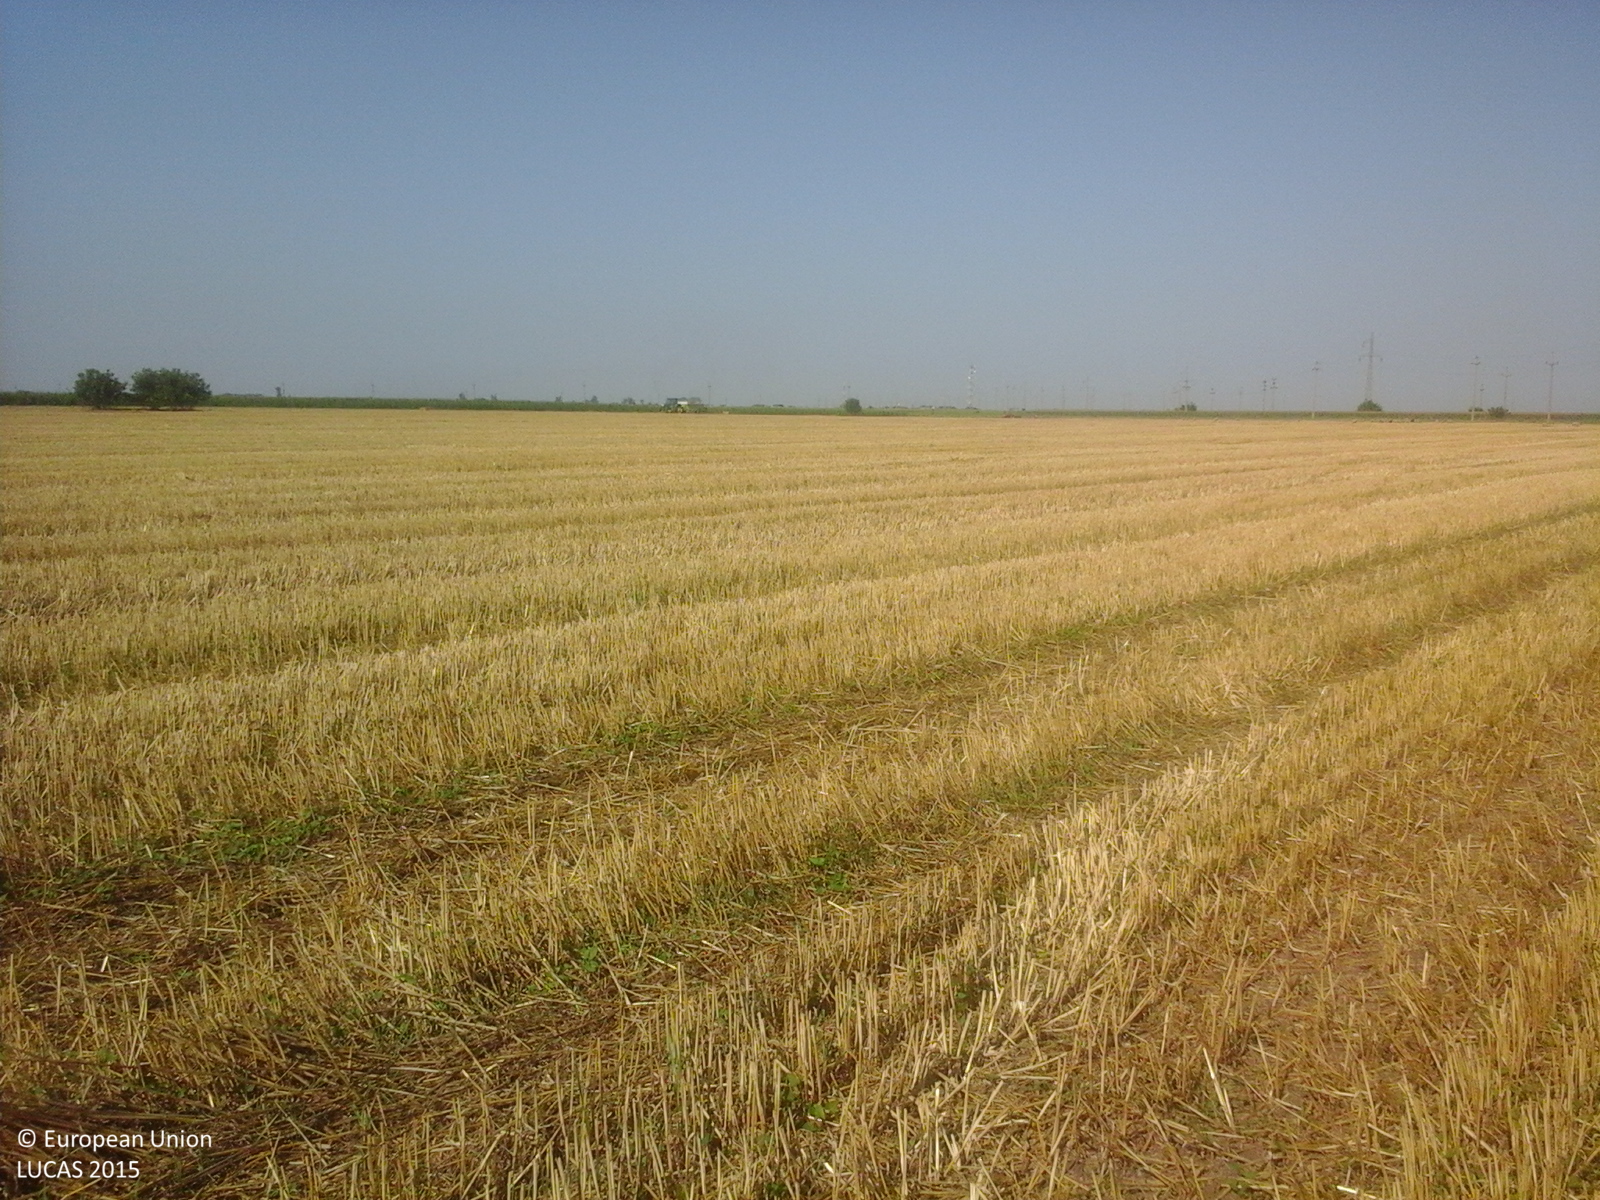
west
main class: Cropland
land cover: Durum wheat
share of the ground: > 75 %
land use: Agriculture (excluding fallow land and kitchen gardens)
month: July
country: RO
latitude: 44.4540
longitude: 27.1612
